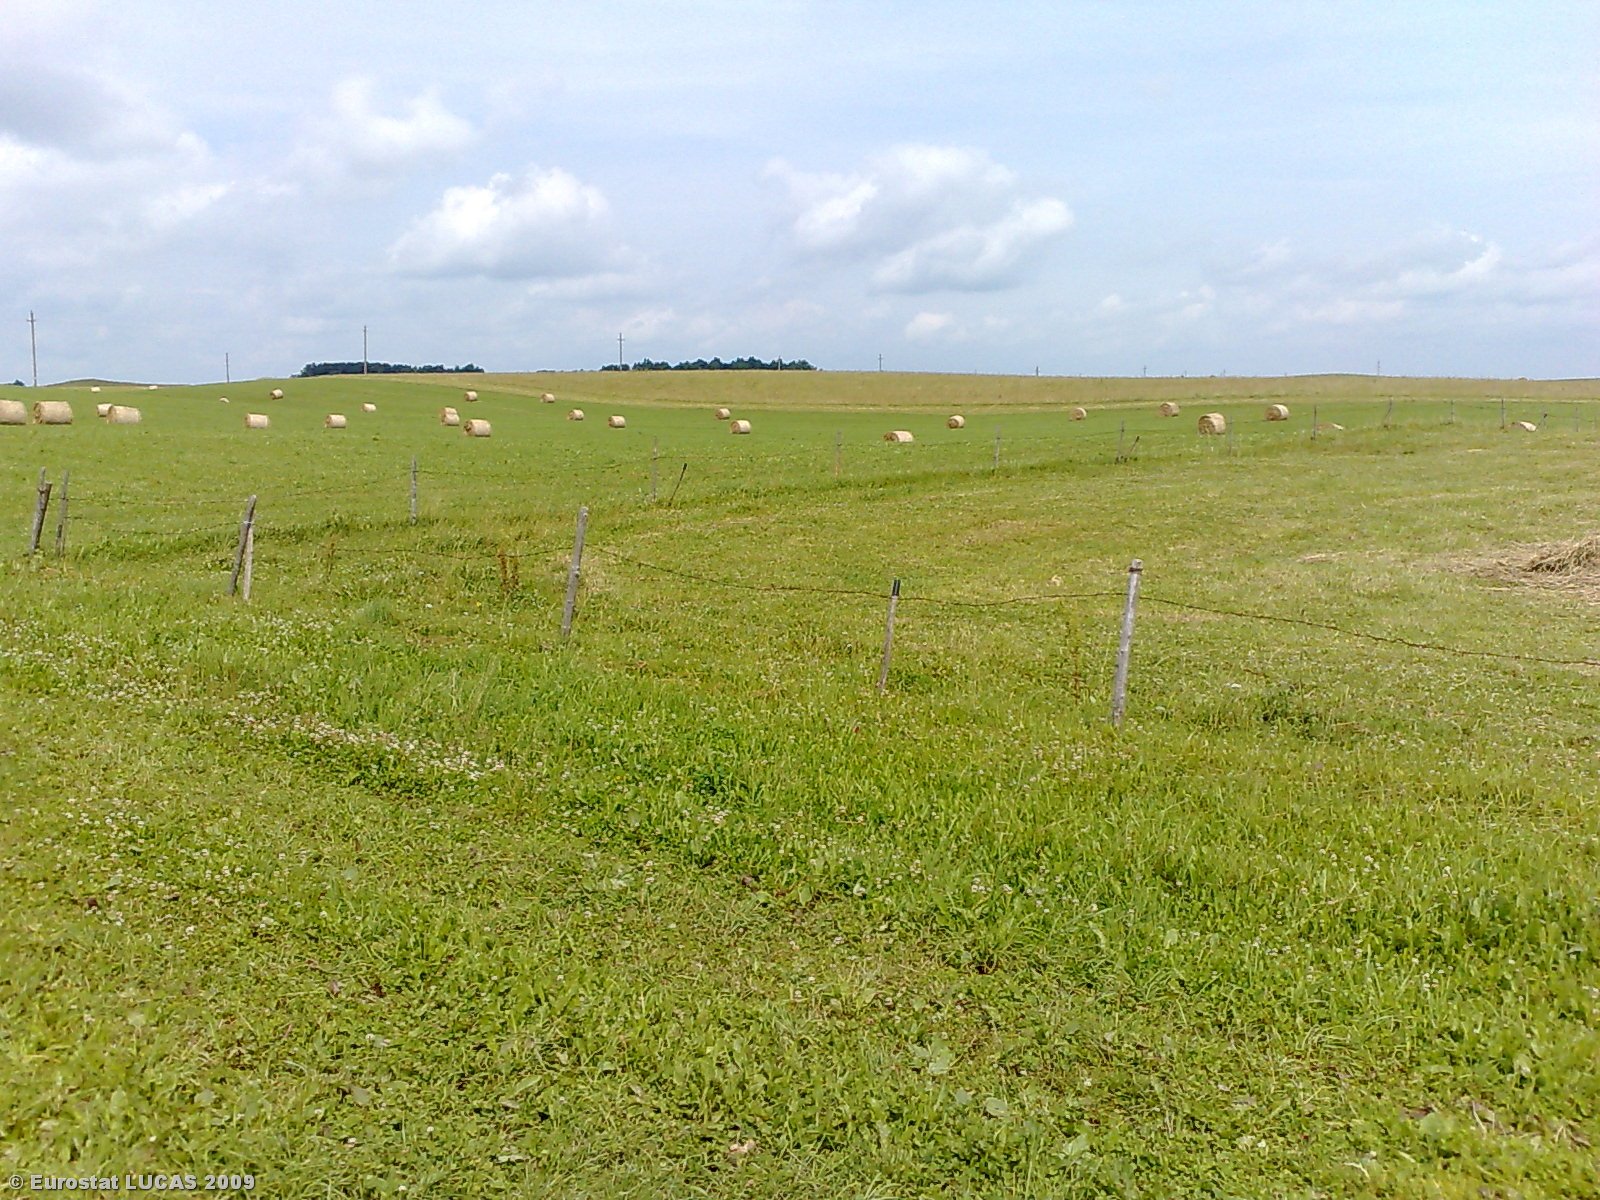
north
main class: Grassland
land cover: Grassland without tree/shrub cover
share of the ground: > 75 %
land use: Agriculture (excluding fallow land and kitchen gardens)
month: July
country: LT
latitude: 55.5826
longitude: 22.7724
